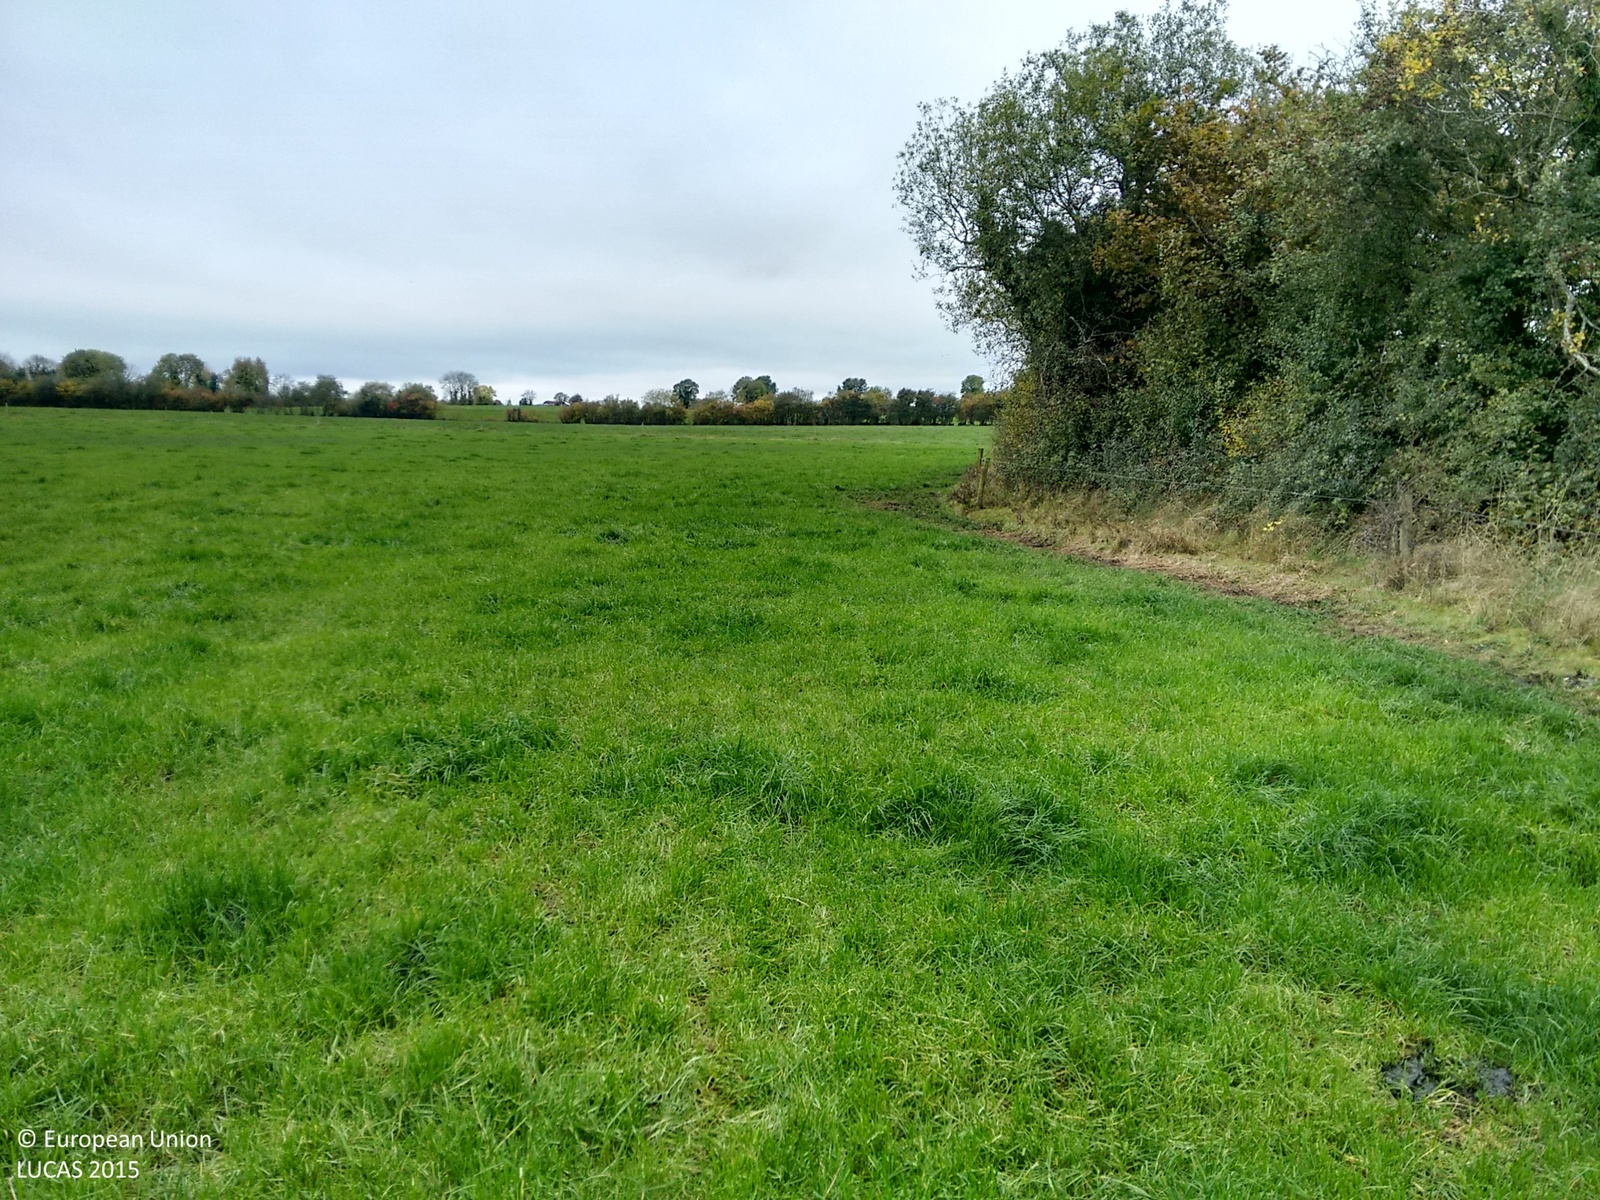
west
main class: Grassland
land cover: Grassland without tree/shrub cover
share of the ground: > 75 %
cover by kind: herbaceous plants 95 %, unconsolidated bare surface 5 %
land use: Agriculture (excluding fallow land and kitchen gardens)
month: October
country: IE
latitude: 52.7344
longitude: -7.7770
